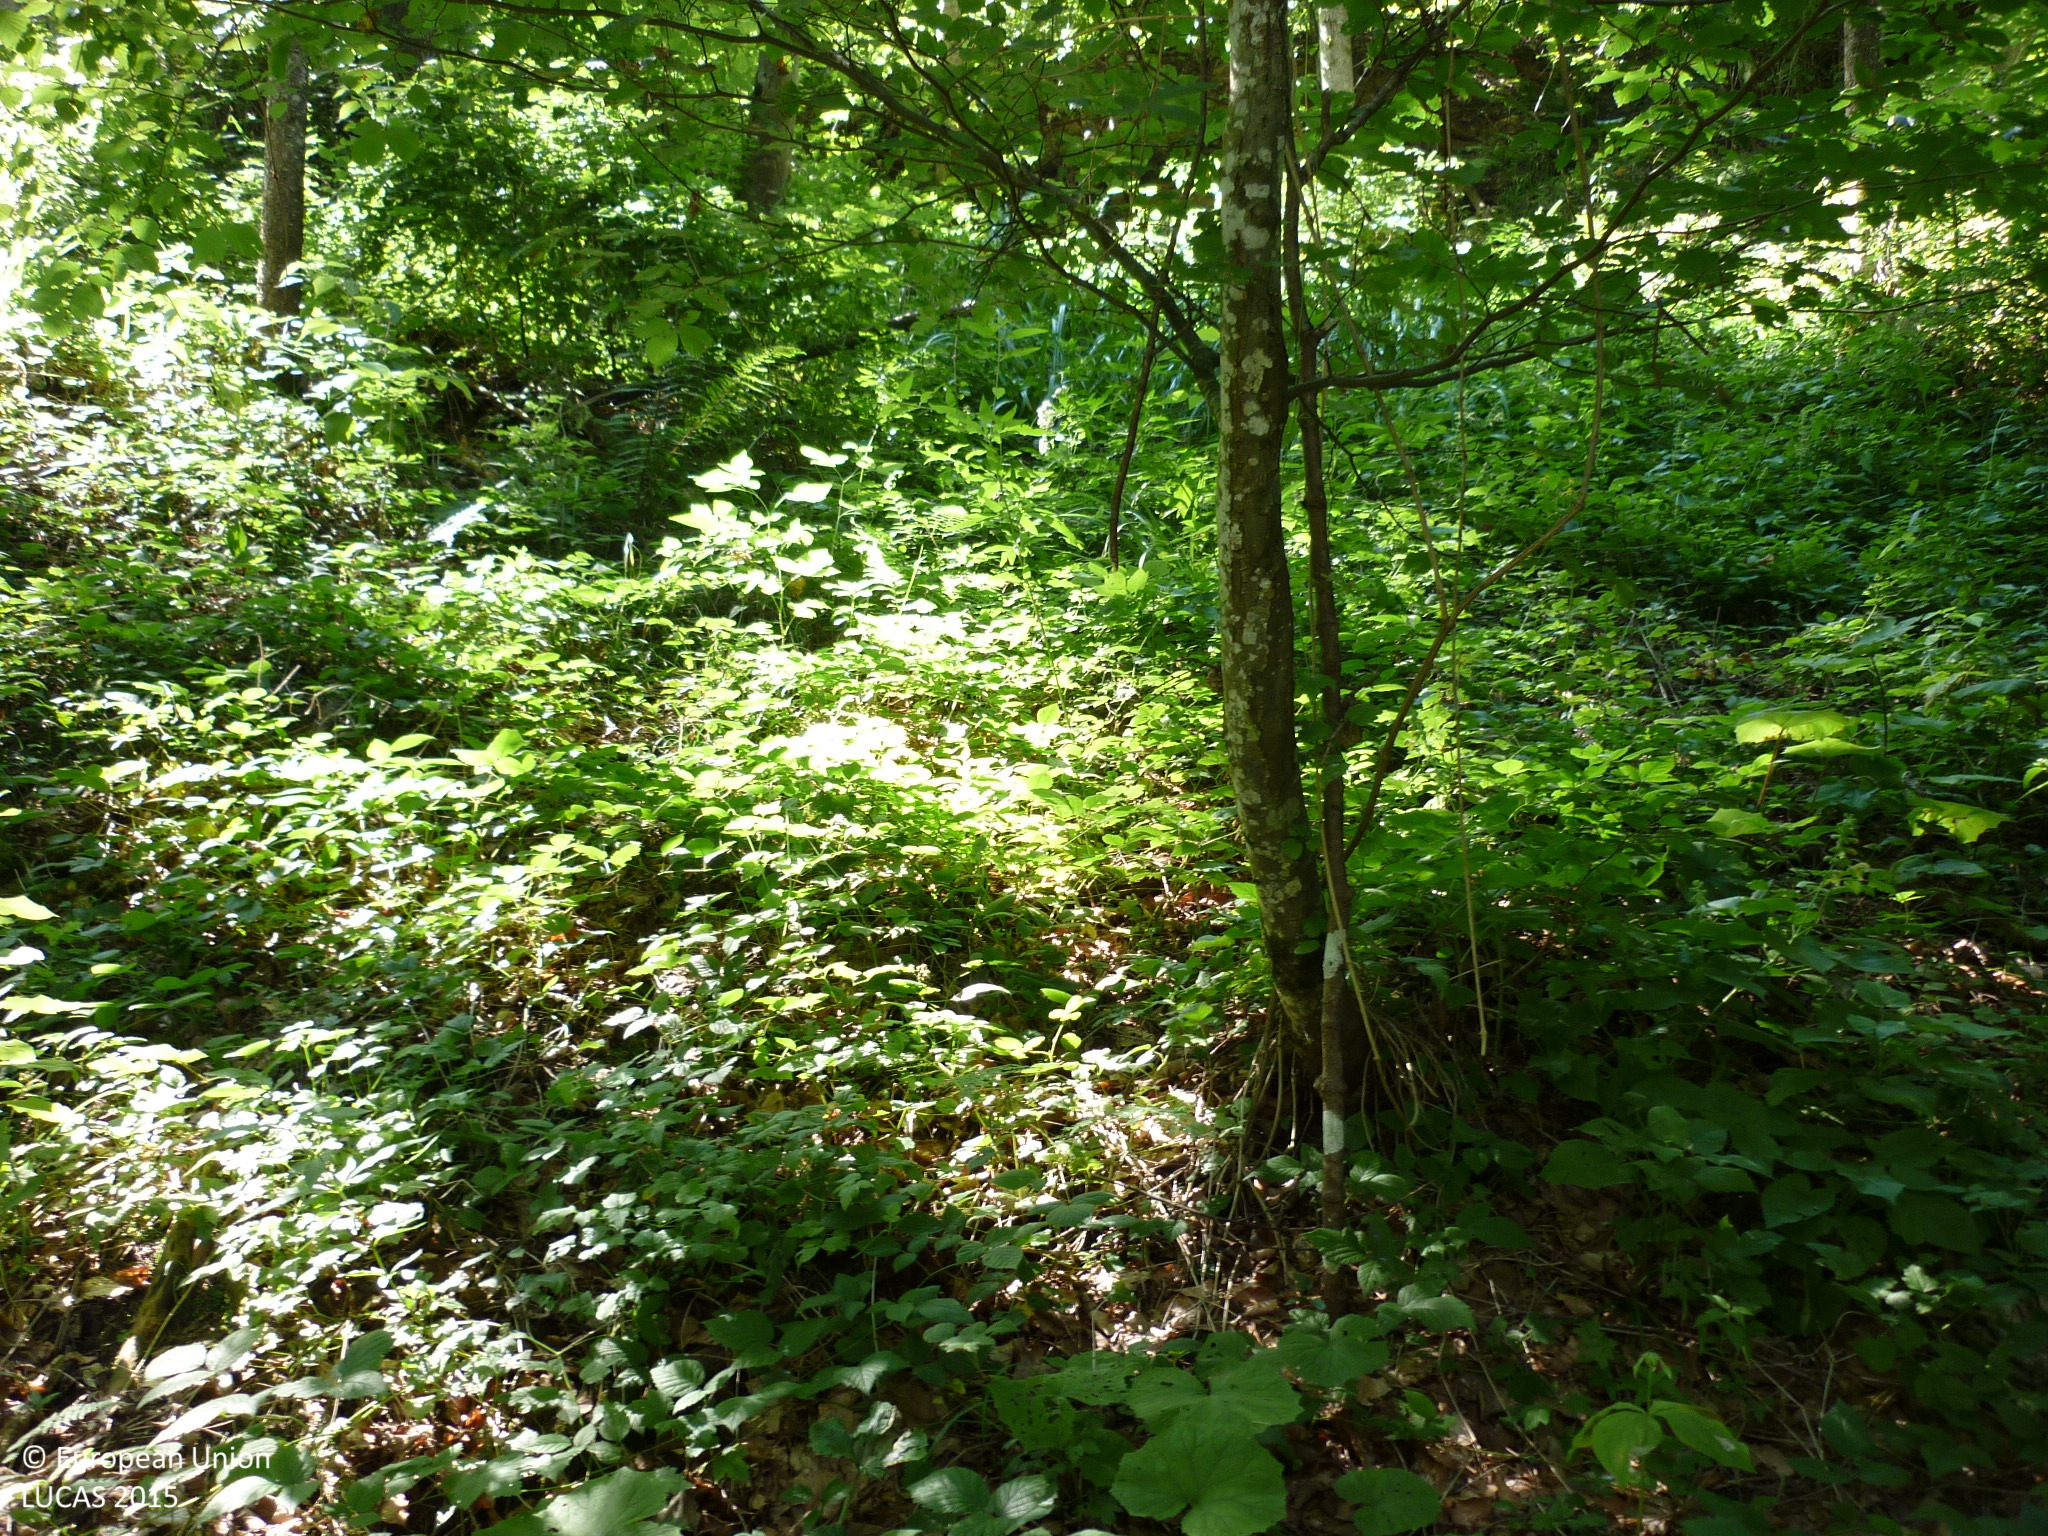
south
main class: Woodland
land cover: Spruce dominated mixed woodland
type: alpine coniferous forest
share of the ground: > 75 %
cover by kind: broadleaved forest trees 70 %, coniferous forest trees 25 %, herbaceous plants 5 %
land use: Forestry
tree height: > 5 m
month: August
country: AT
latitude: 47.7430
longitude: 14.3071
